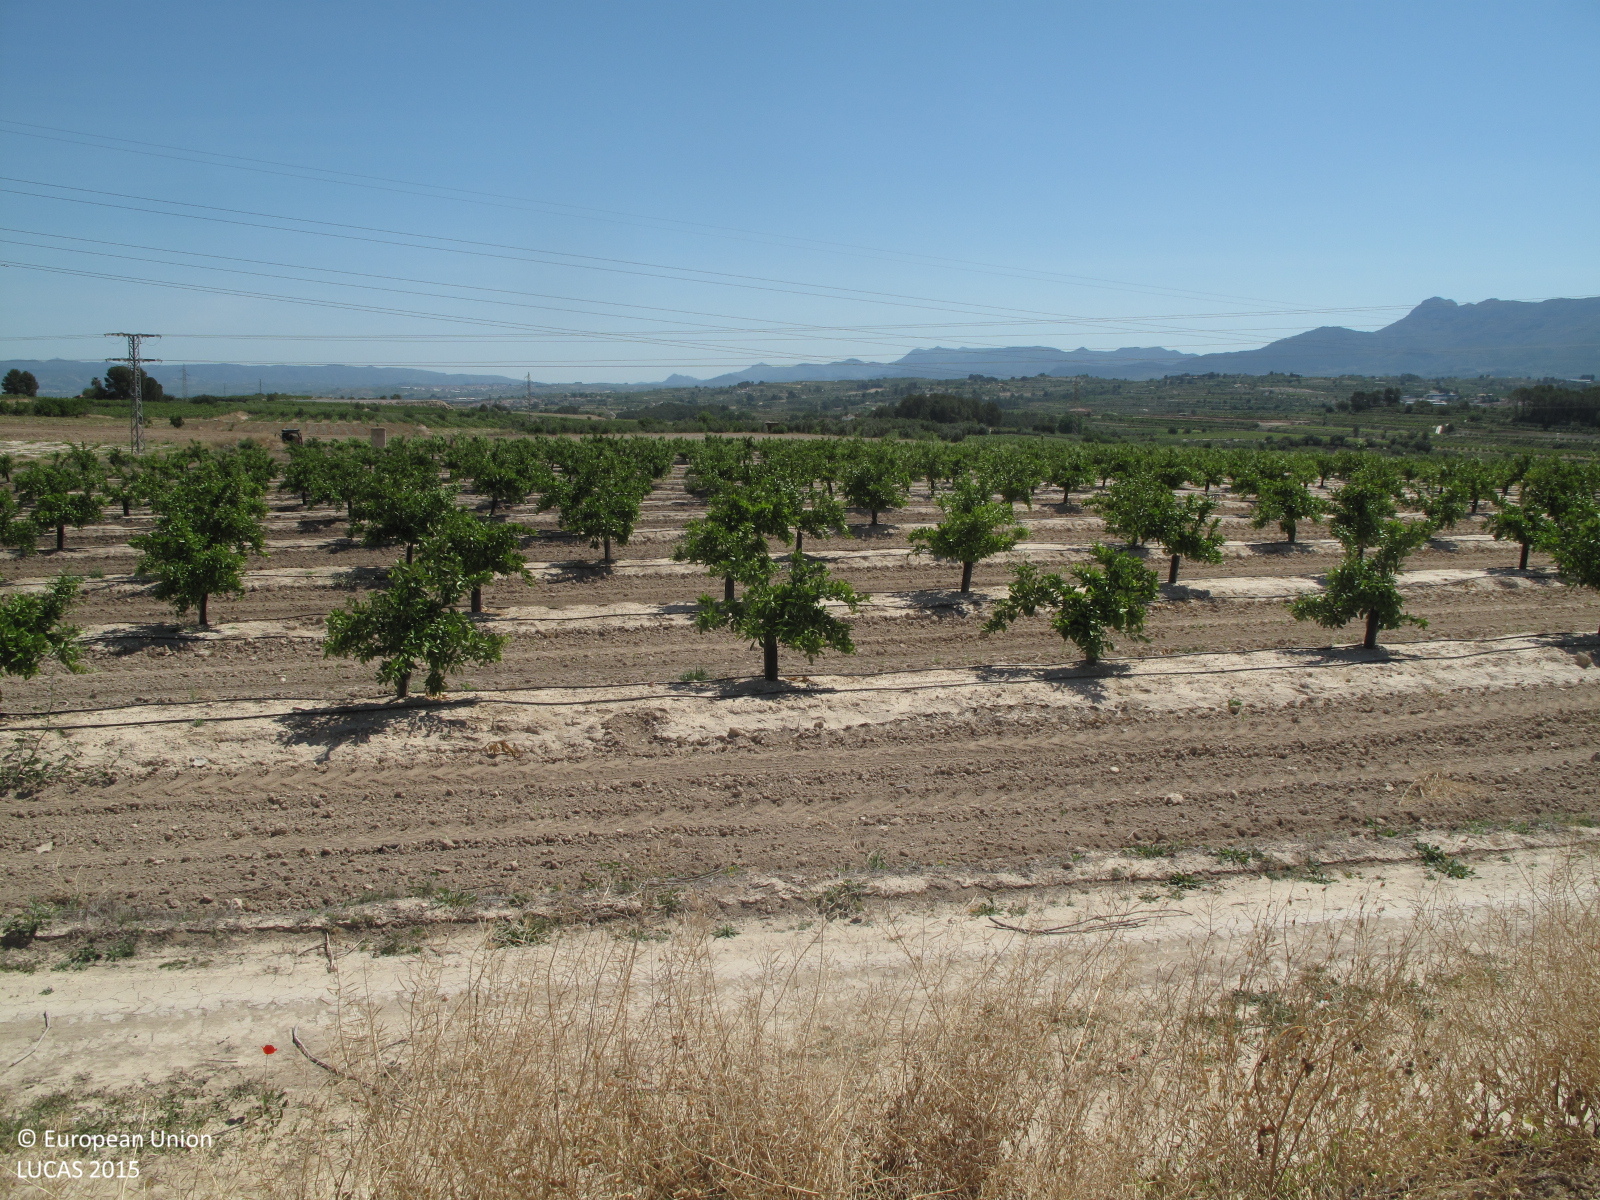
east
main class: Cropland
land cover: Vineyards
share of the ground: 25 - 50 %
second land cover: Other bare soil
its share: > 75 %
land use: Agriculture (excluding fallow land and kitchen gardens)
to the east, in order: Vineyards; Other bare soil; Grass margins; Tracks; Grass margins; Other citrus fruit; Electric lines; Other citrus fruit; Grass margins; Tracks; Grass margins; Vineyards; Electric lines; Vineyards; Grass margins; Tracks; Grass margins; Other bare soil; Grass margins; Other bare soil
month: May
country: ES
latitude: 38.8772
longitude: -0.5386
